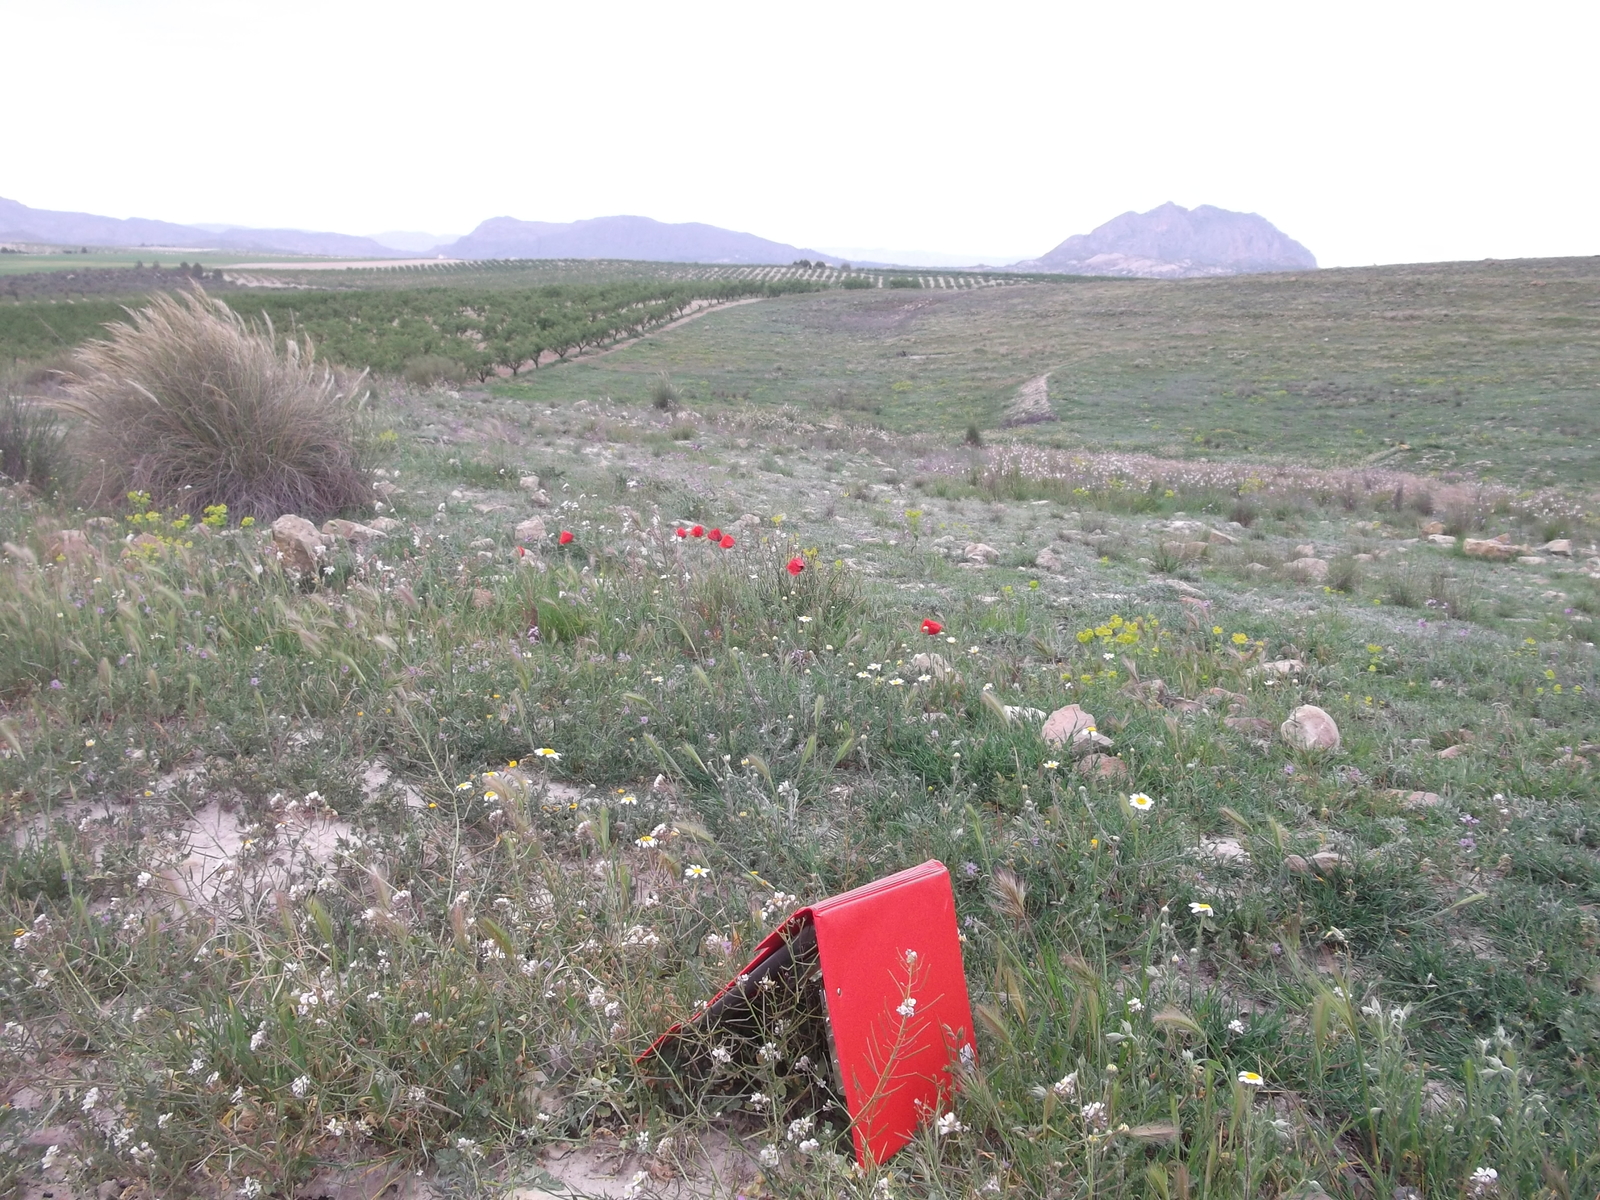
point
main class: Grassland
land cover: Grassland without tree/shrub cover
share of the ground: 50 - 75 %
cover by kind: herbaceous plants 50 %, consolidated bare surface 50 %
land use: Abandoned areas
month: April
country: ES
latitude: 38.1396
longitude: -1.5458
